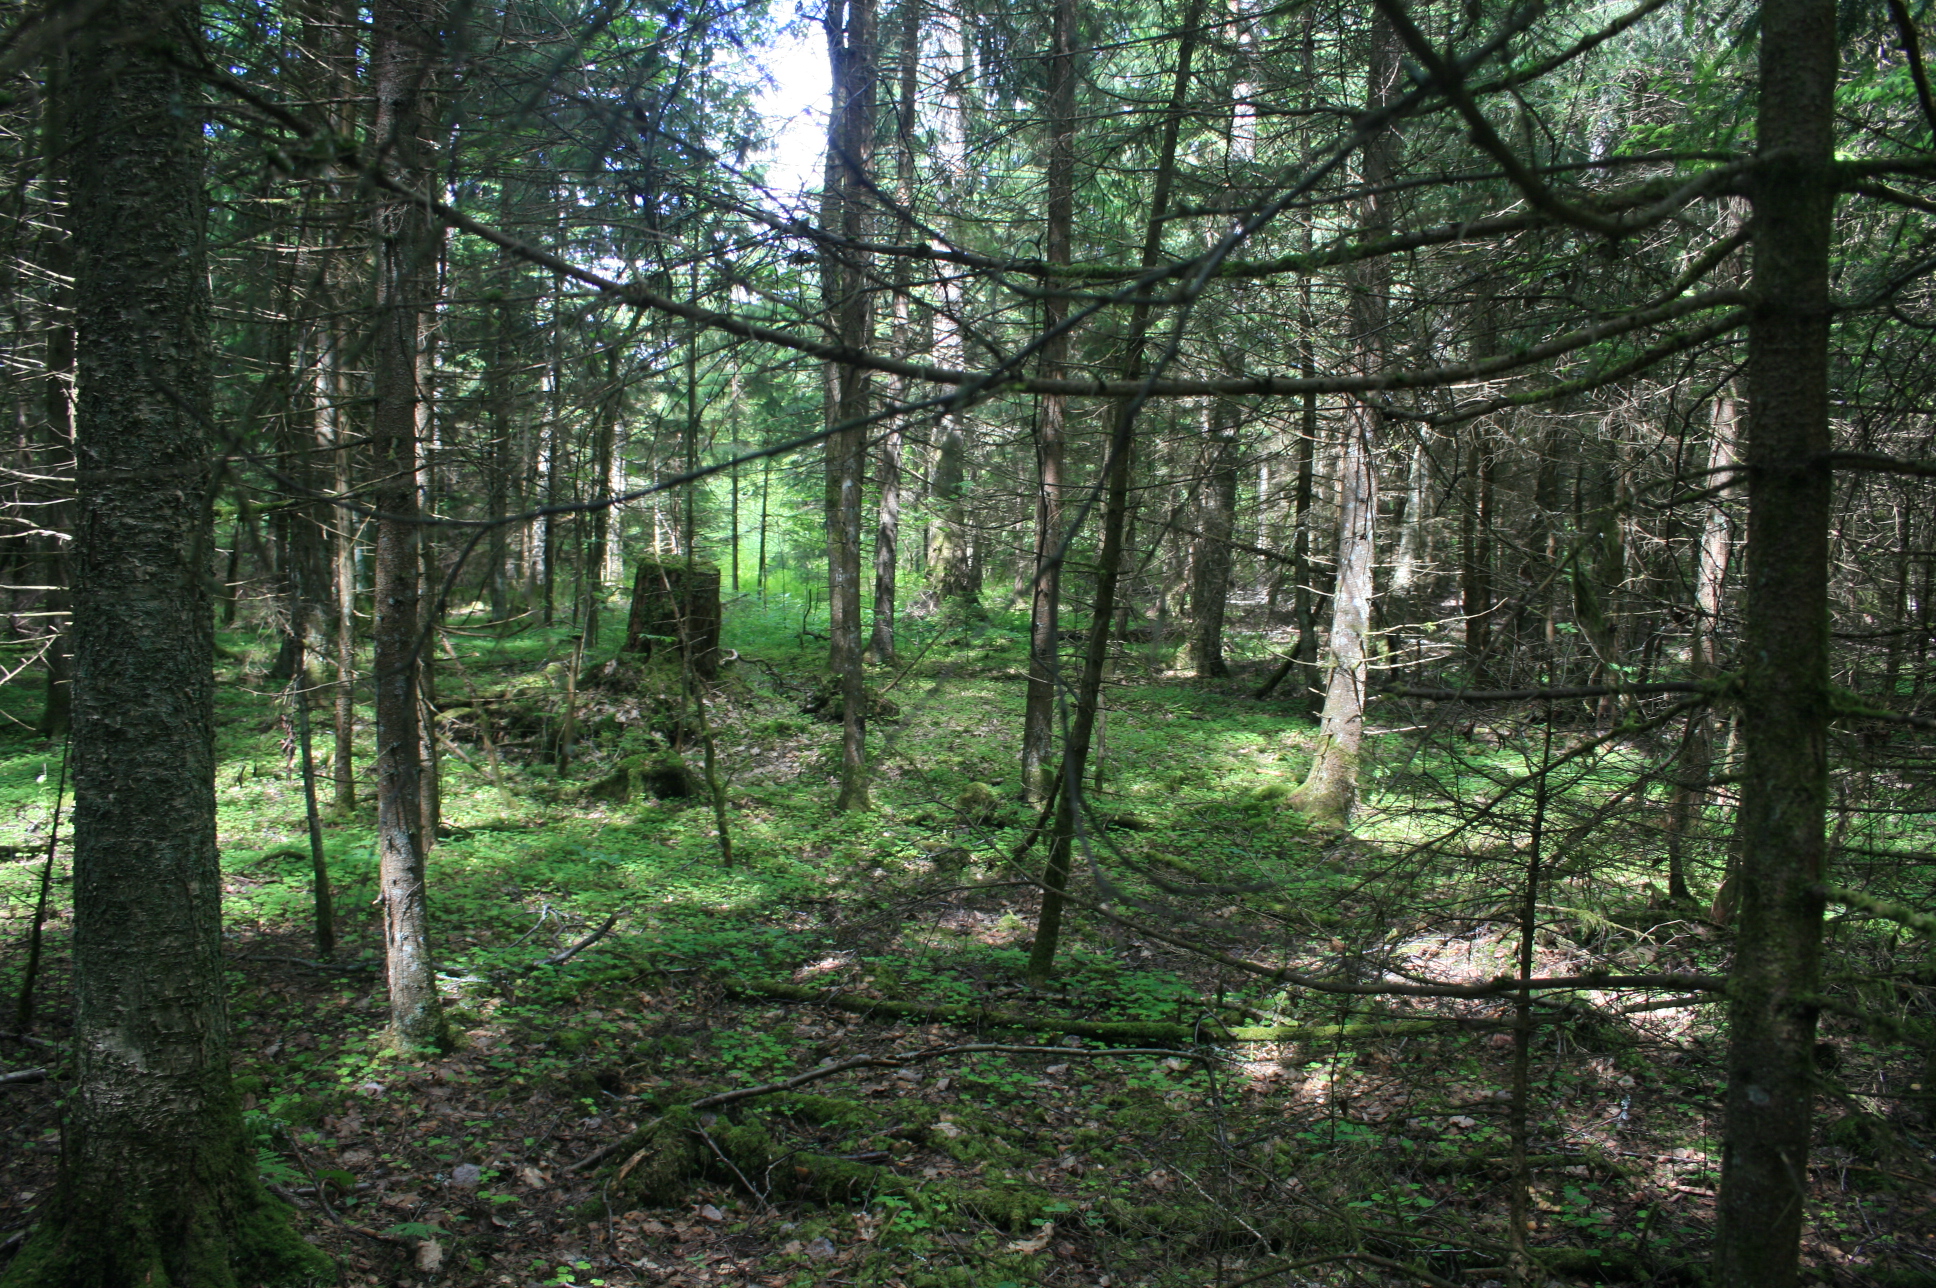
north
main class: Woodland
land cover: Spruce dominated mixed woodland
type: hemiboreal forest and nemoral coniferous forest and mixed broadleaved-coniferous forest
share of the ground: > 75 %
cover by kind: broadleaved forest trees 50 %, coniferous forest trees 40 %, herbaceous plants 10 %
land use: Forestry
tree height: > 5 m
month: June
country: LT
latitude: 55.2996
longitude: 22.1366
